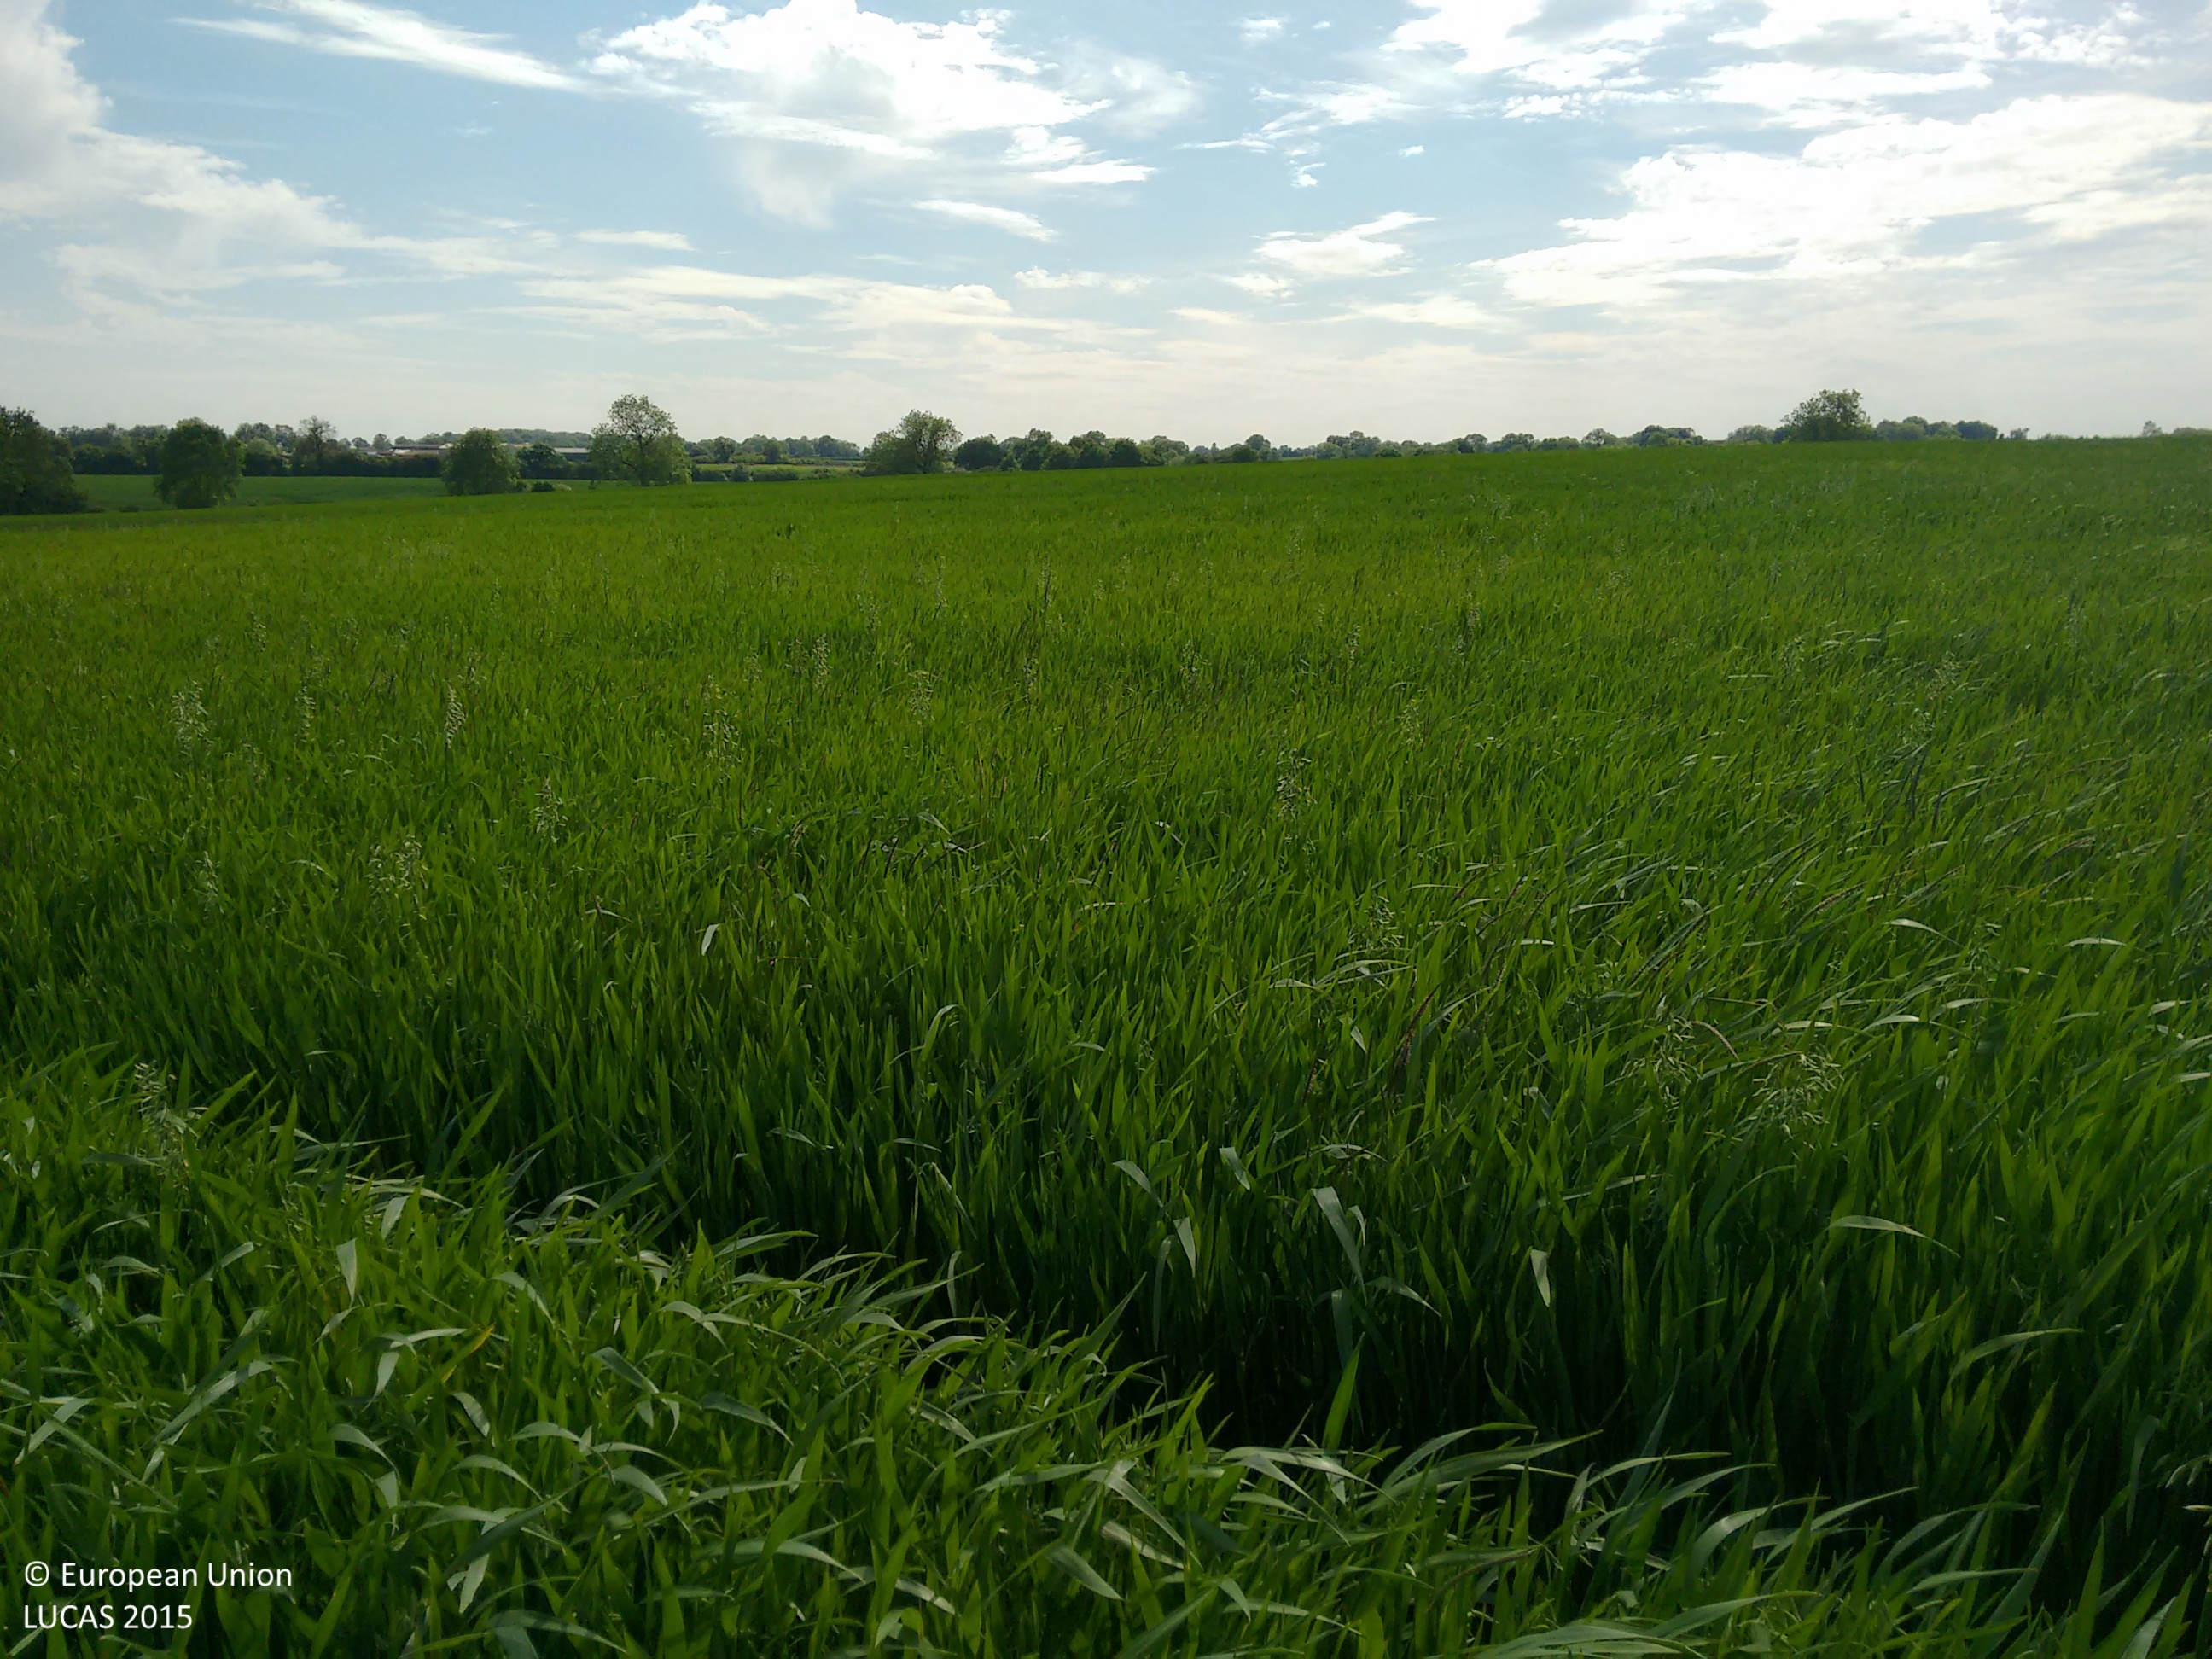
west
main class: Cropland
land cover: Oats
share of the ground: > 75 %
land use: Agriculture (excluding fallow land and kitchen gardens)
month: June
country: GB
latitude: 52.4827
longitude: -1.3727
